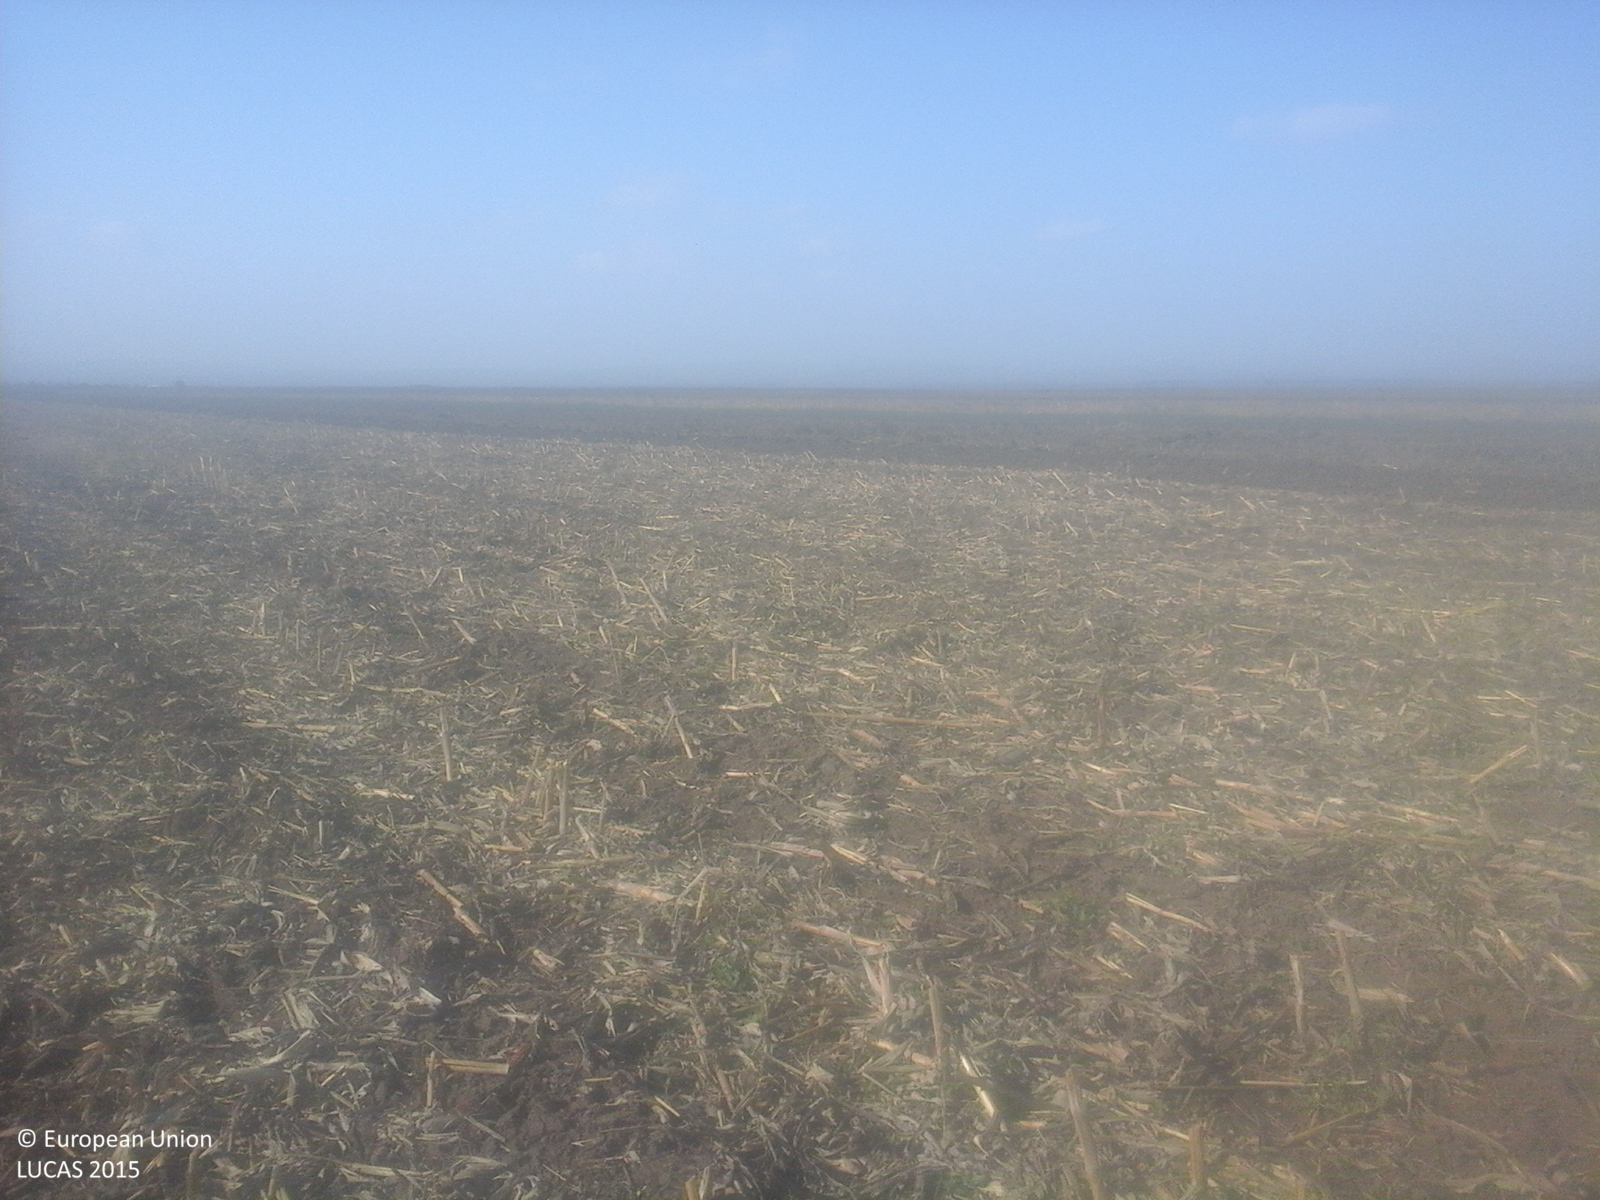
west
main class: Cropland
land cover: Maize
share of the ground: 50 - 75 %
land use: Agriculture (excluding fallow land and kitchen gardens)
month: October
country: RO
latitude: 45.4486
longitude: 27.2666
